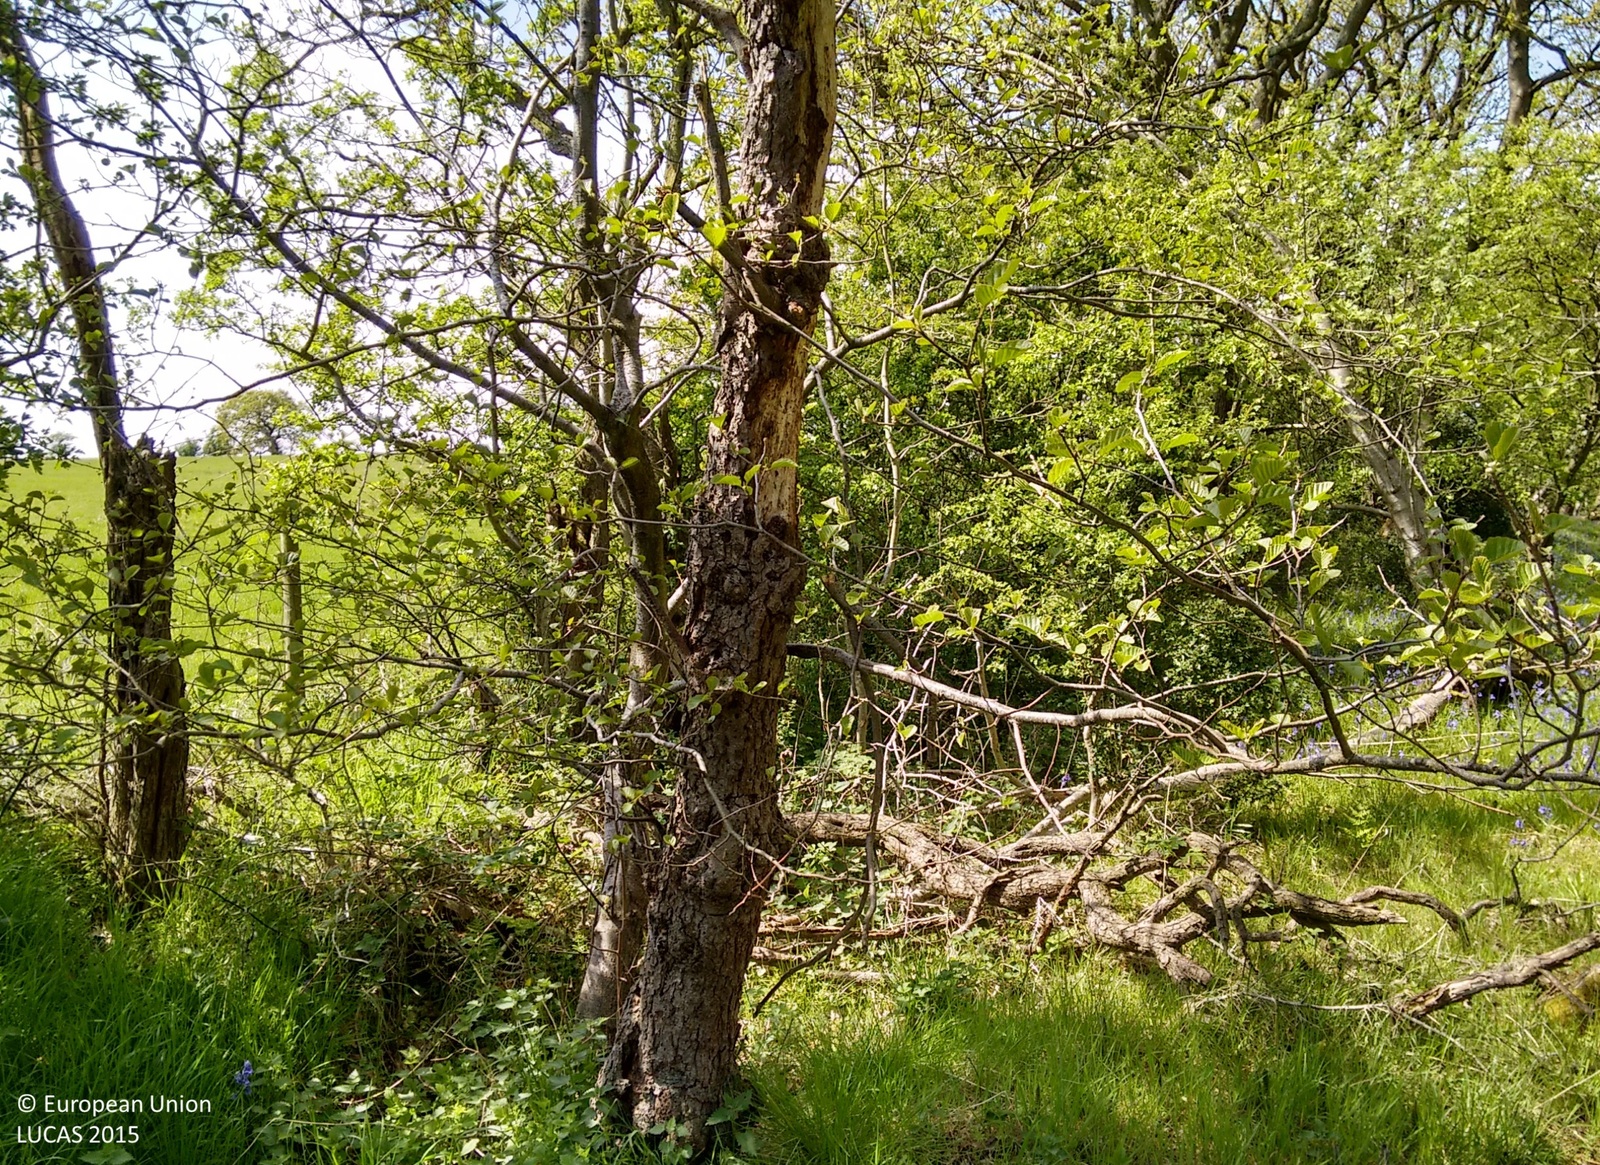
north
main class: Woodland
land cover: Broadleaved woodland
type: mesophytic deciduous forest
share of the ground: > 75 %
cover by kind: broadleaved forest trees 100 %
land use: Semi-natural and natural areas not in use
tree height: > 5 m
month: May
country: GB
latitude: 53.7943
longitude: -2.6217
